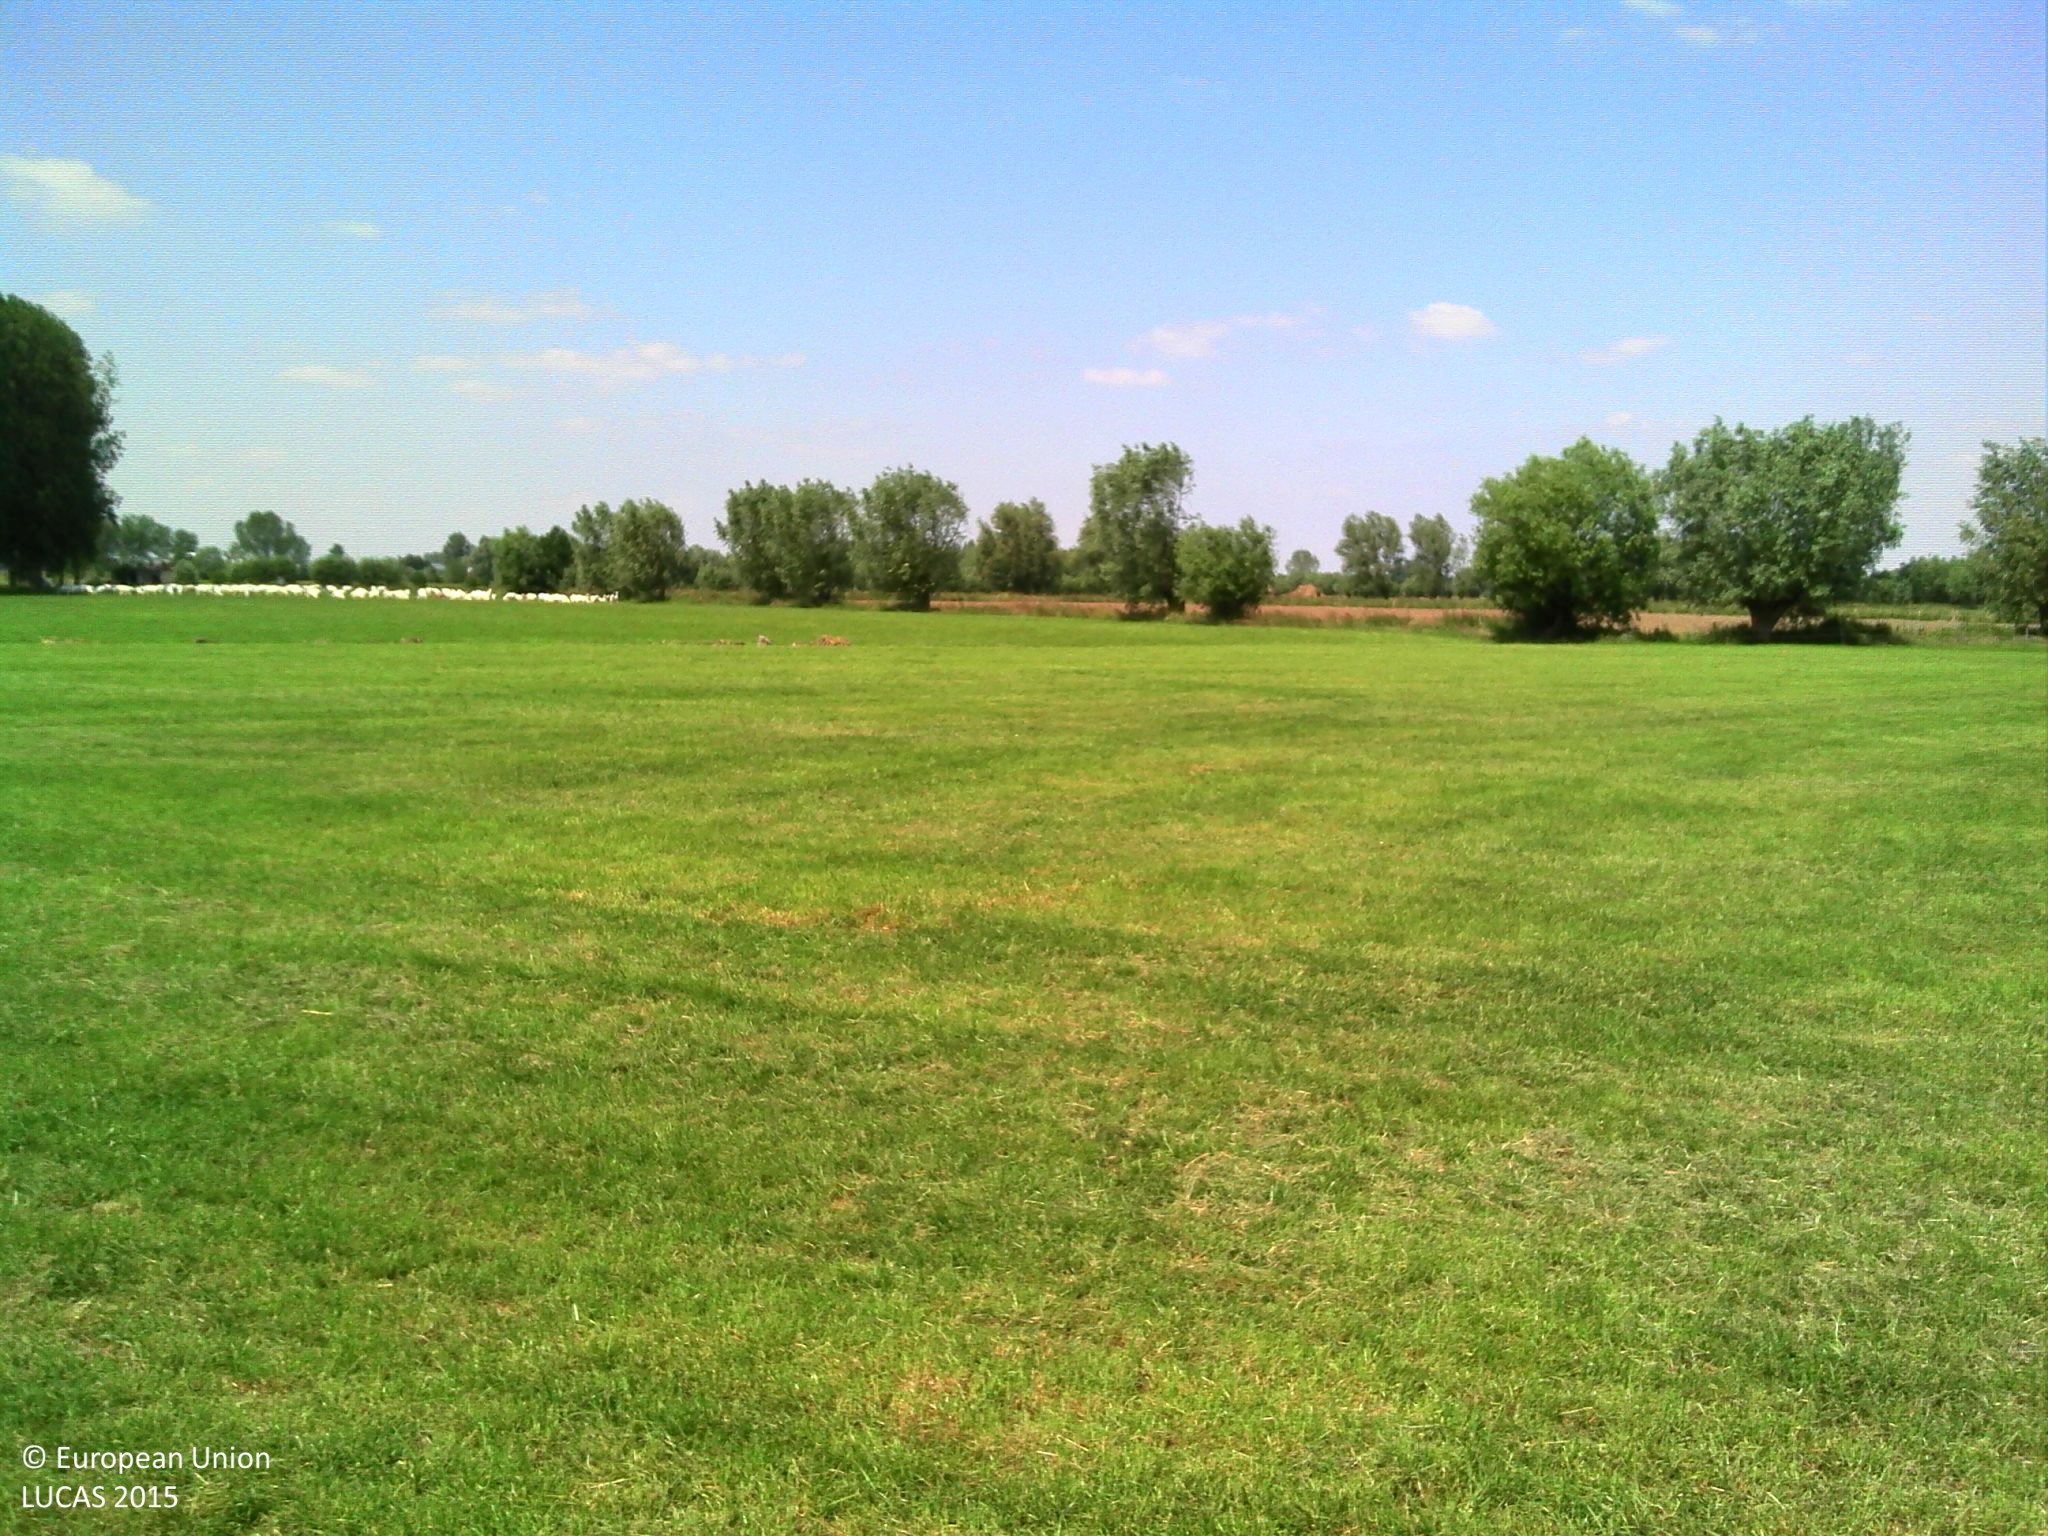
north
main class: Grassland
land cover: Grassland without tree/shrub cover
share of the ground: > 75 %
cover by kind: herbaceous plants 100 %
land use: Agriculture (excluding fallow land and kitchen gardens)
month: June
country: BE
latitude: 51.0727
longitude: 4.0142
